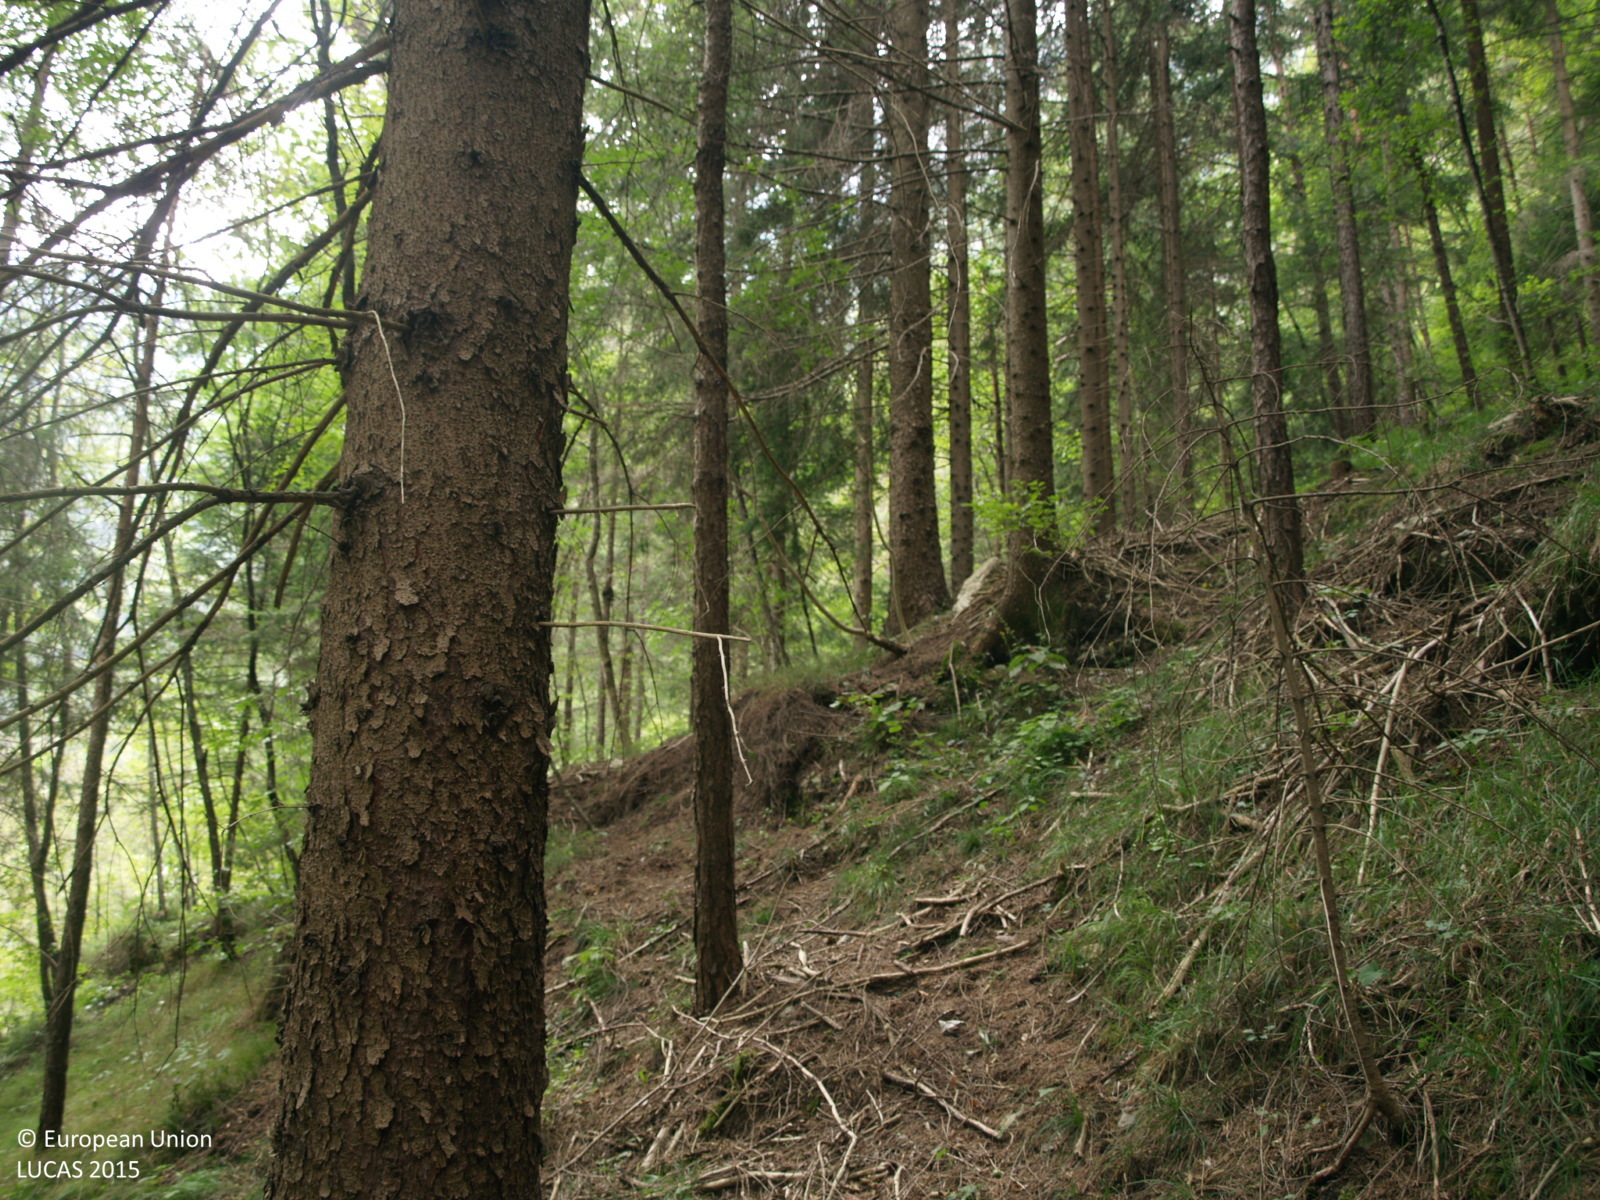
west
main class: Woodland
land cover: Spruce dominated coniferous woodland
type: alpine coniferous forest
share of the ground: > 75 %
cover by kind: coniferous forest trees 90 %, broadleaved forest trees 10 %
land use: Forestry
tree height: > 5 m
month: May
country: IT
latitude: 46.0249
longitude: 10.6579
